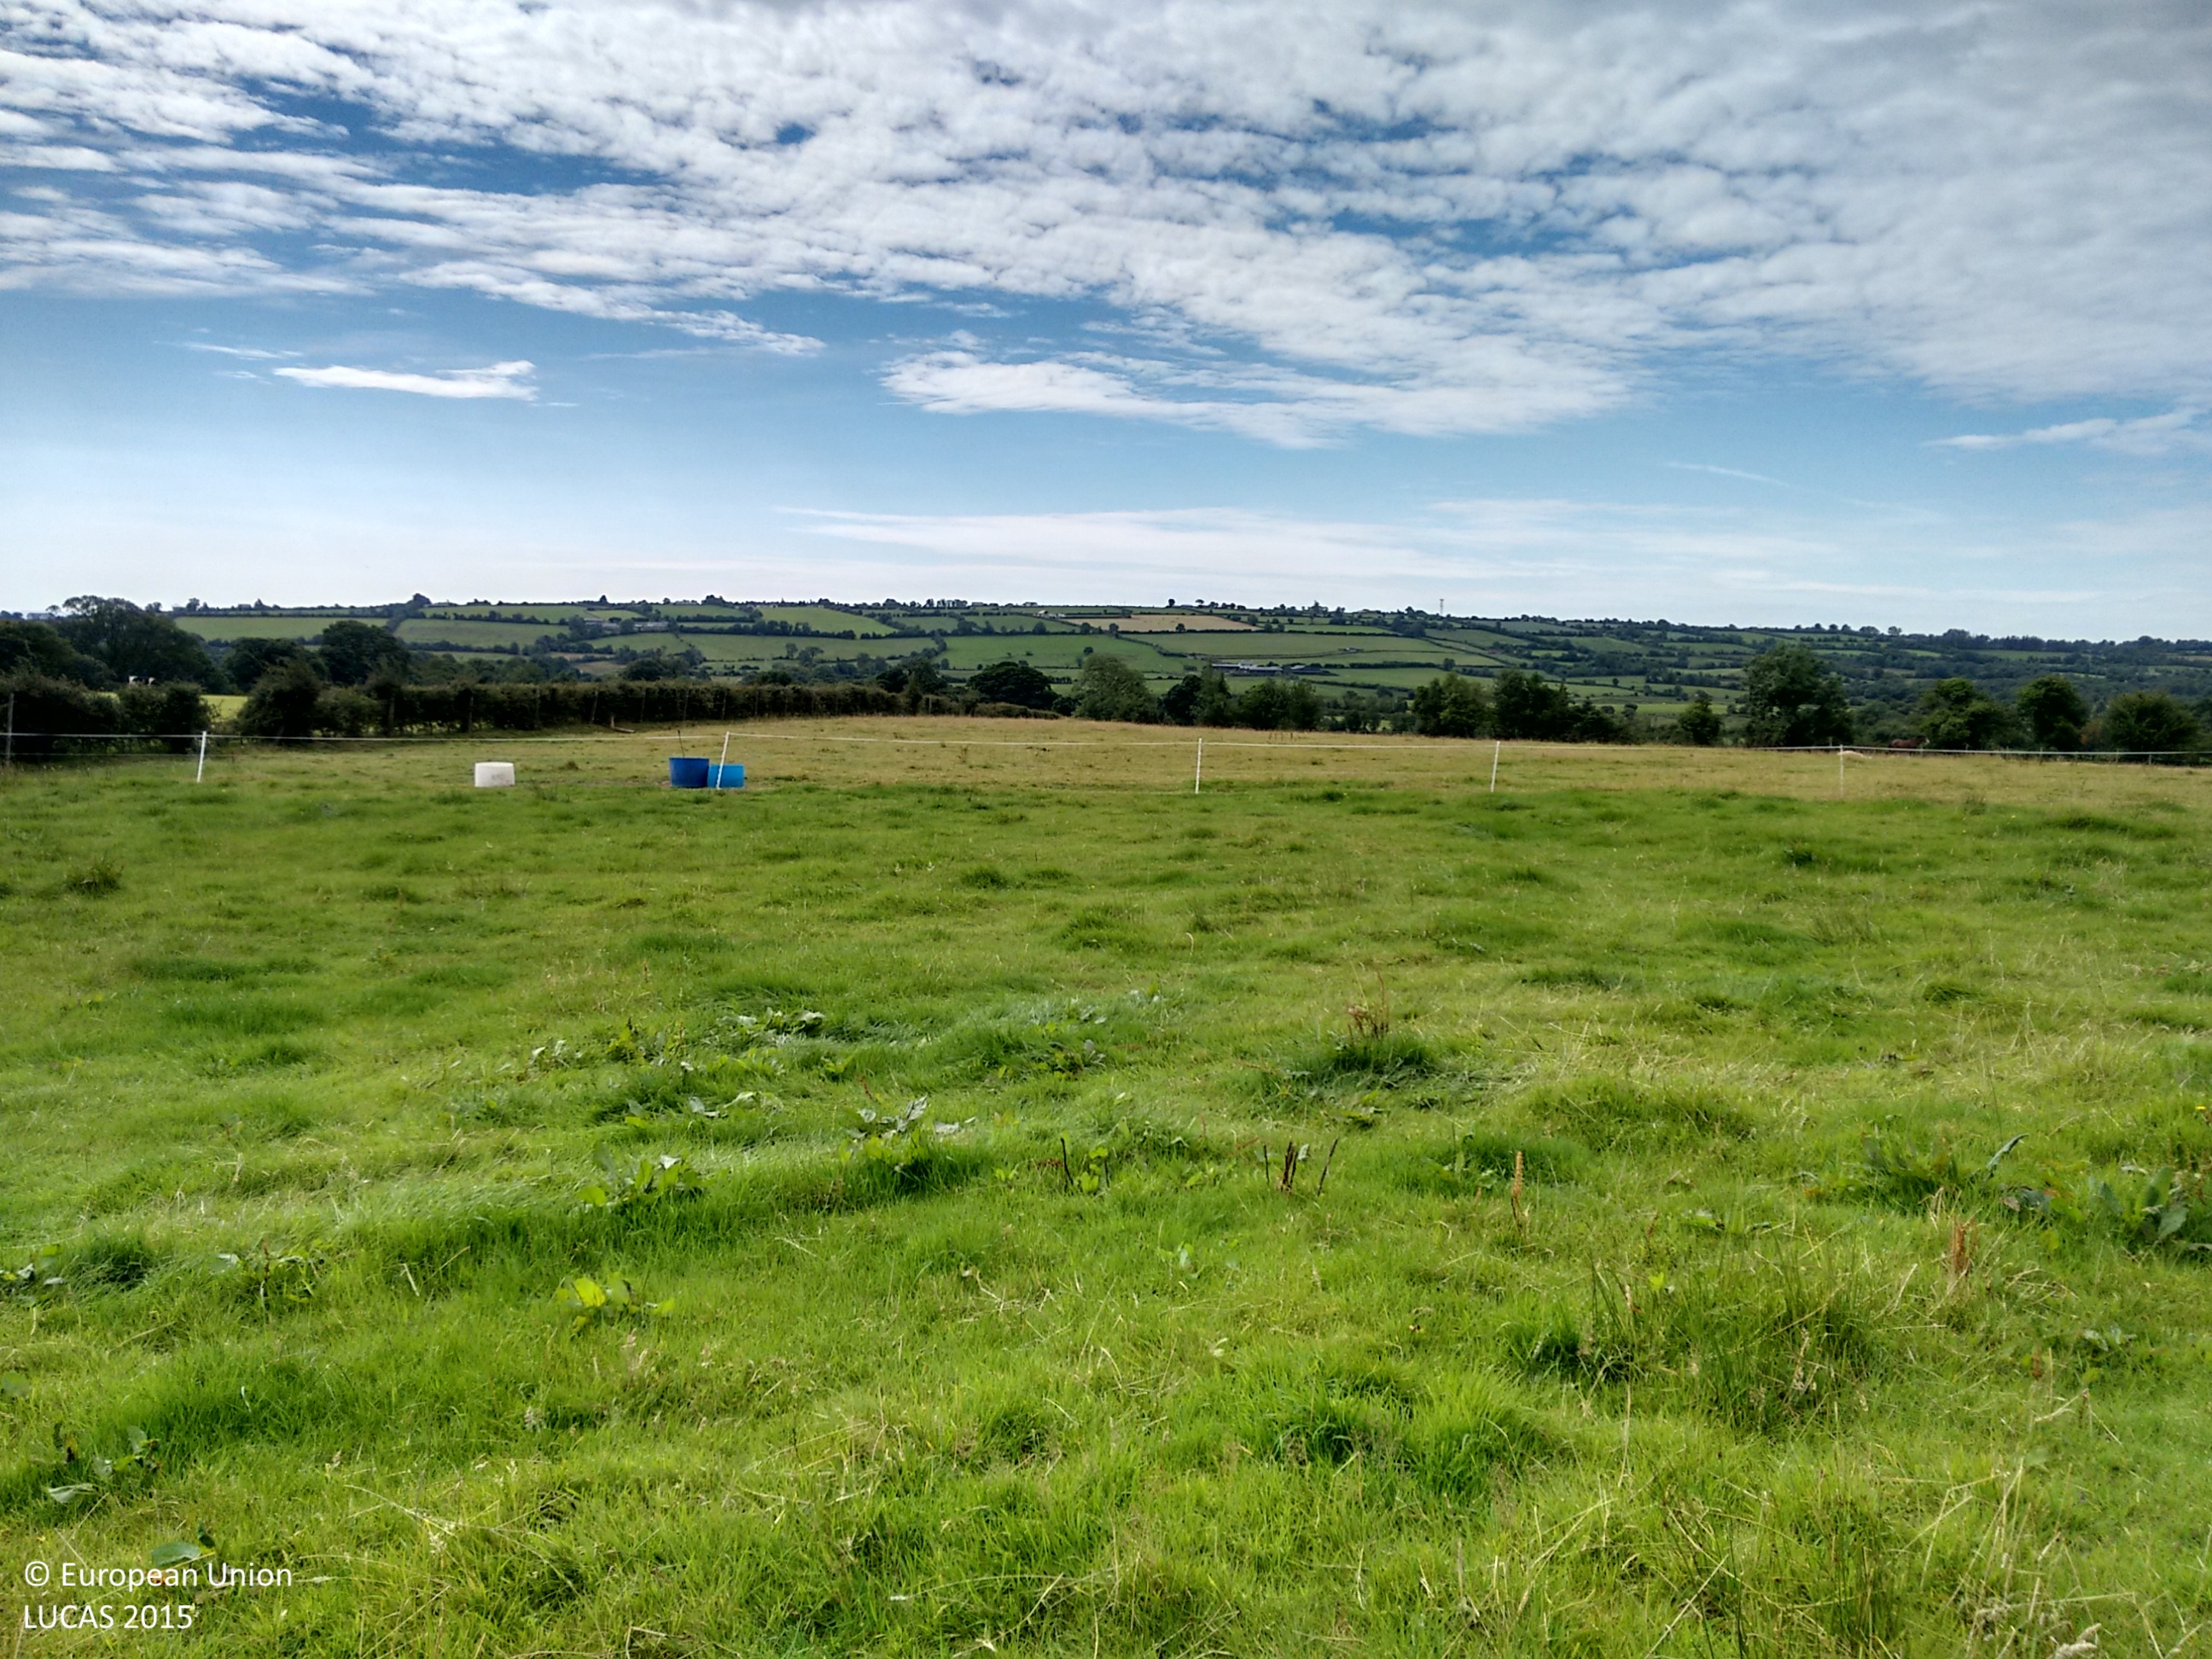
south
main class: Grassland
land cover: Grassland without tree/shrub cover
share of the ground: > 75 %
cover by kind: herbaceous plants 100 %
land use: Agriculture (excluding fallow land and kitchen gardens)
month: August
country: IE
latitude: 53.0295
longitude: -7.5306
